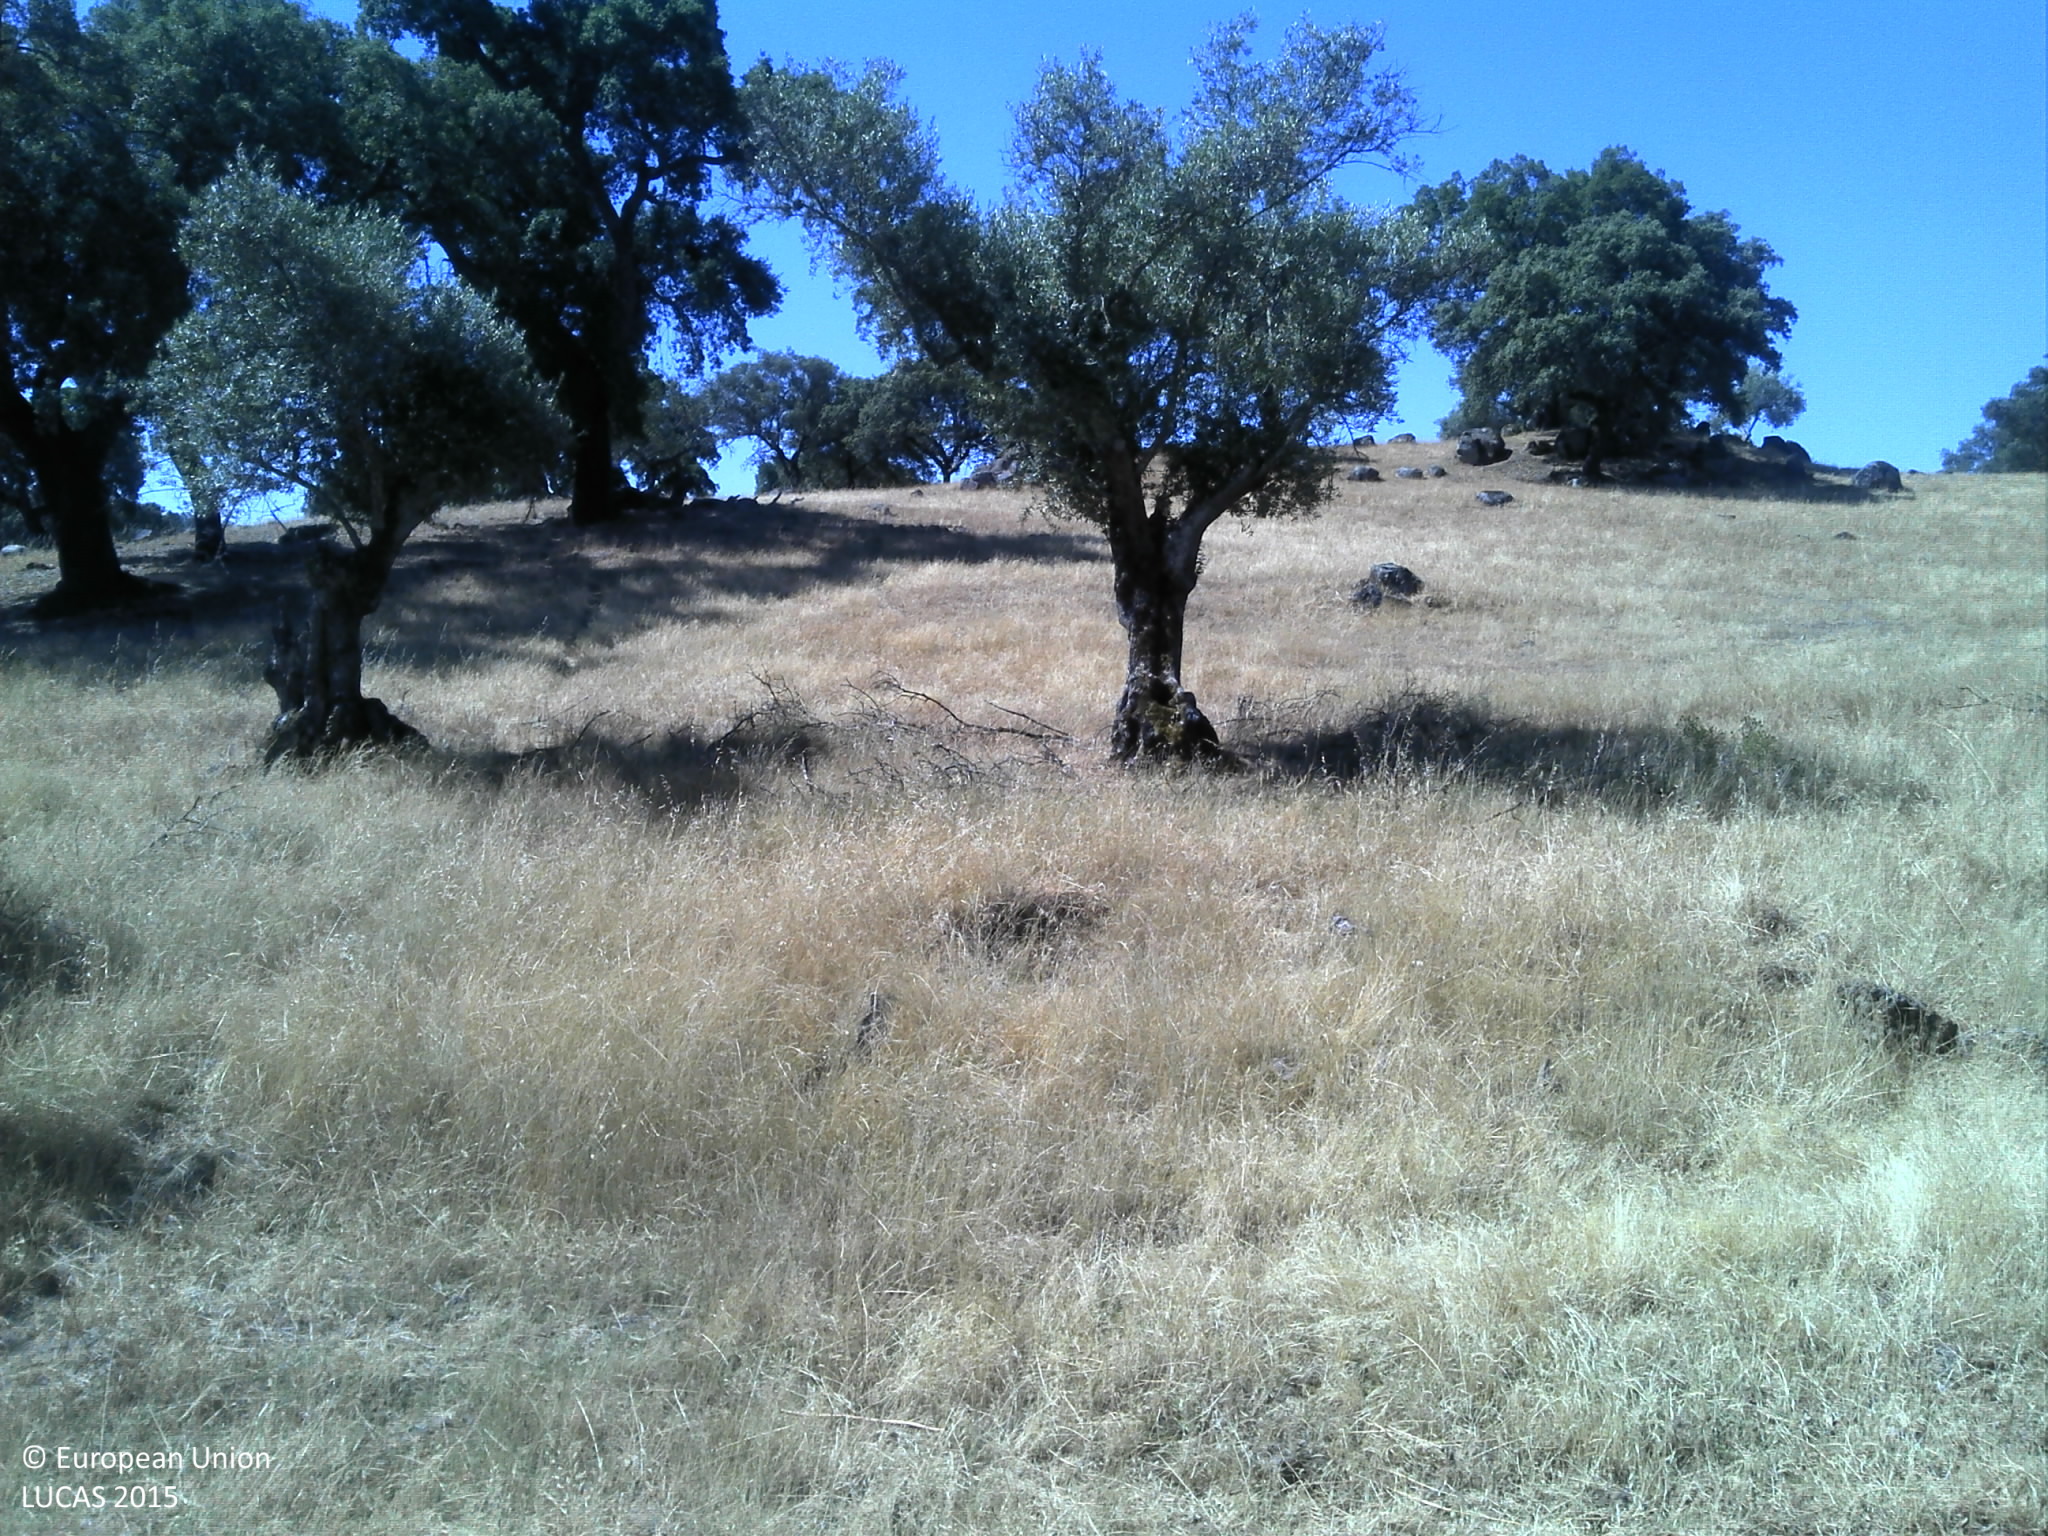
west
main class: Woodland
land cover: Broadleaved woodland
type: broadleaved evergreen forest
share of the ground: 25 - 50 %
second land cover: Grassland without tree/shrub cover
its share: 50 - 75 %
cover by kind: herbaceous plants 50 %, broadleaved forest trees 40 %, unconsolidated bare surface 10 %
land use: Agriculture (excluding fallow land and kitchen gardens)
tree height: > 5 m
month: June
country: PT
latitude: 39.9602
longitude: -7.3654
